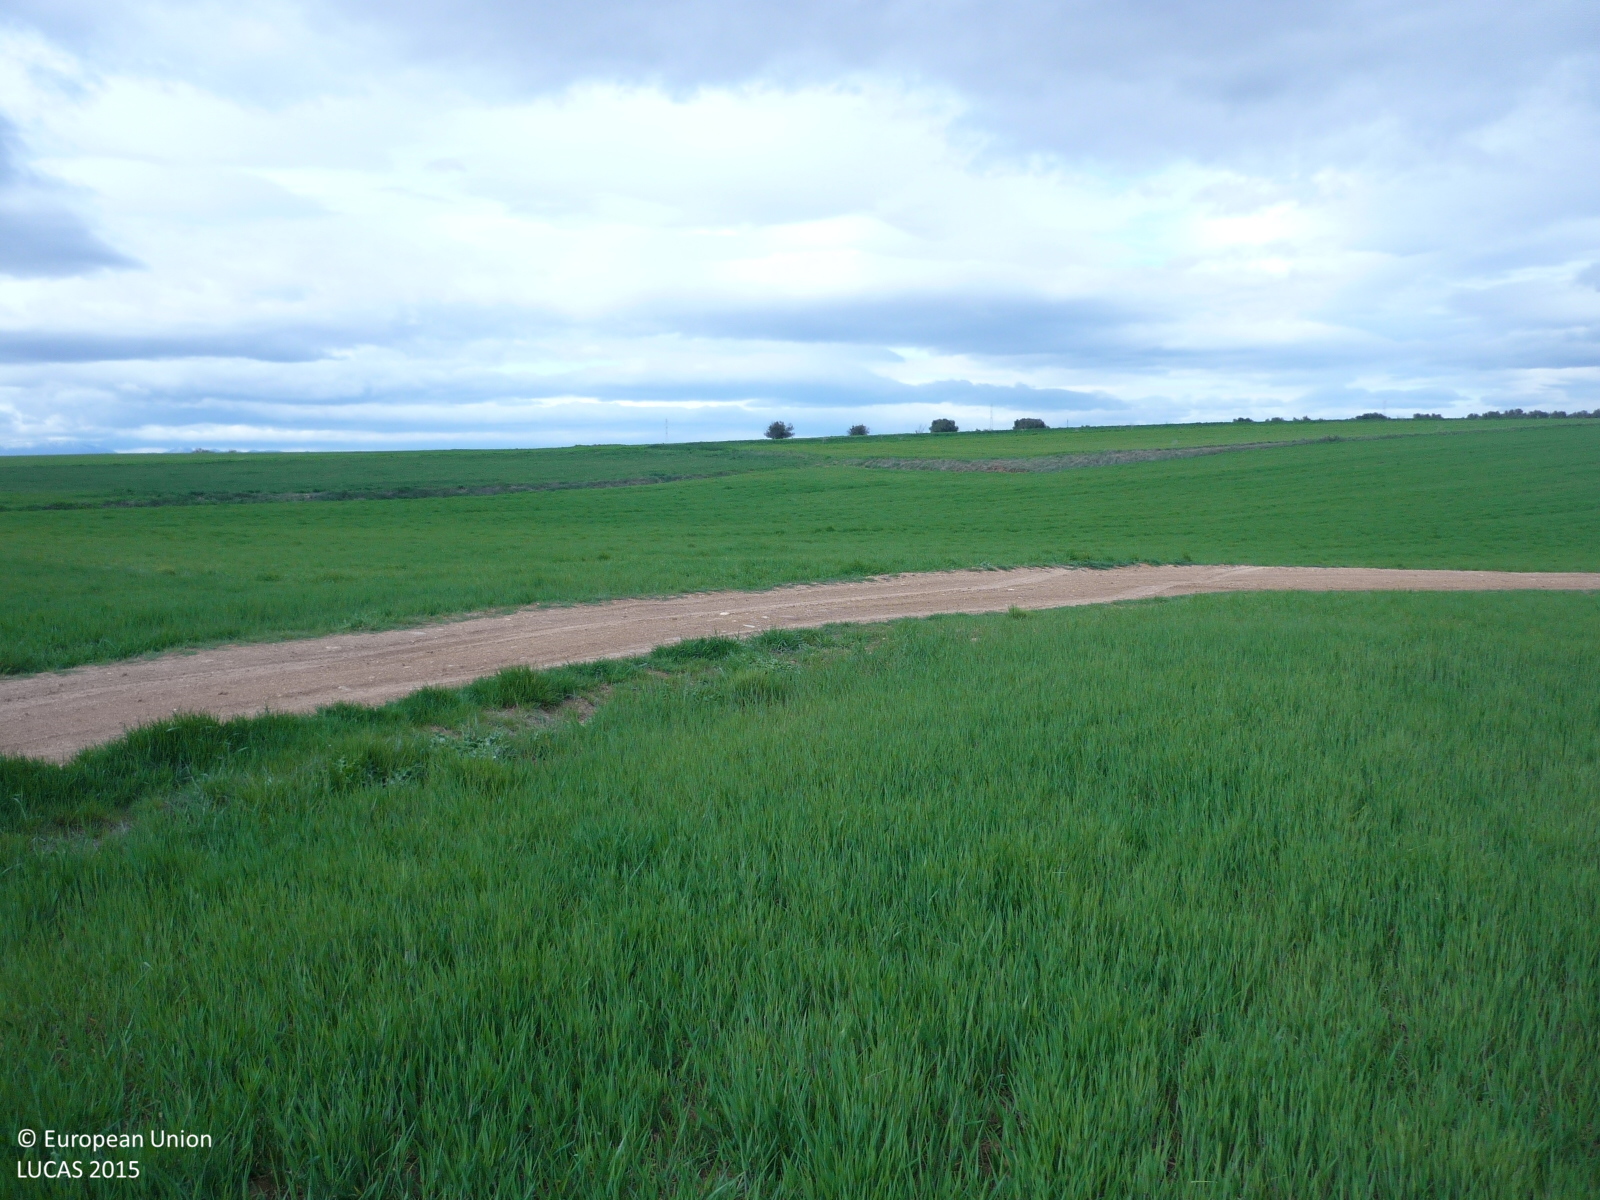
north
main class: Cropland
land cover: Barley
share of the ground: > 75 %
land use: Agriculture (excluding fallow land and kitchen gardens)
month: March
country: ES
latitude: 40.5371
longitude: -3.5075
